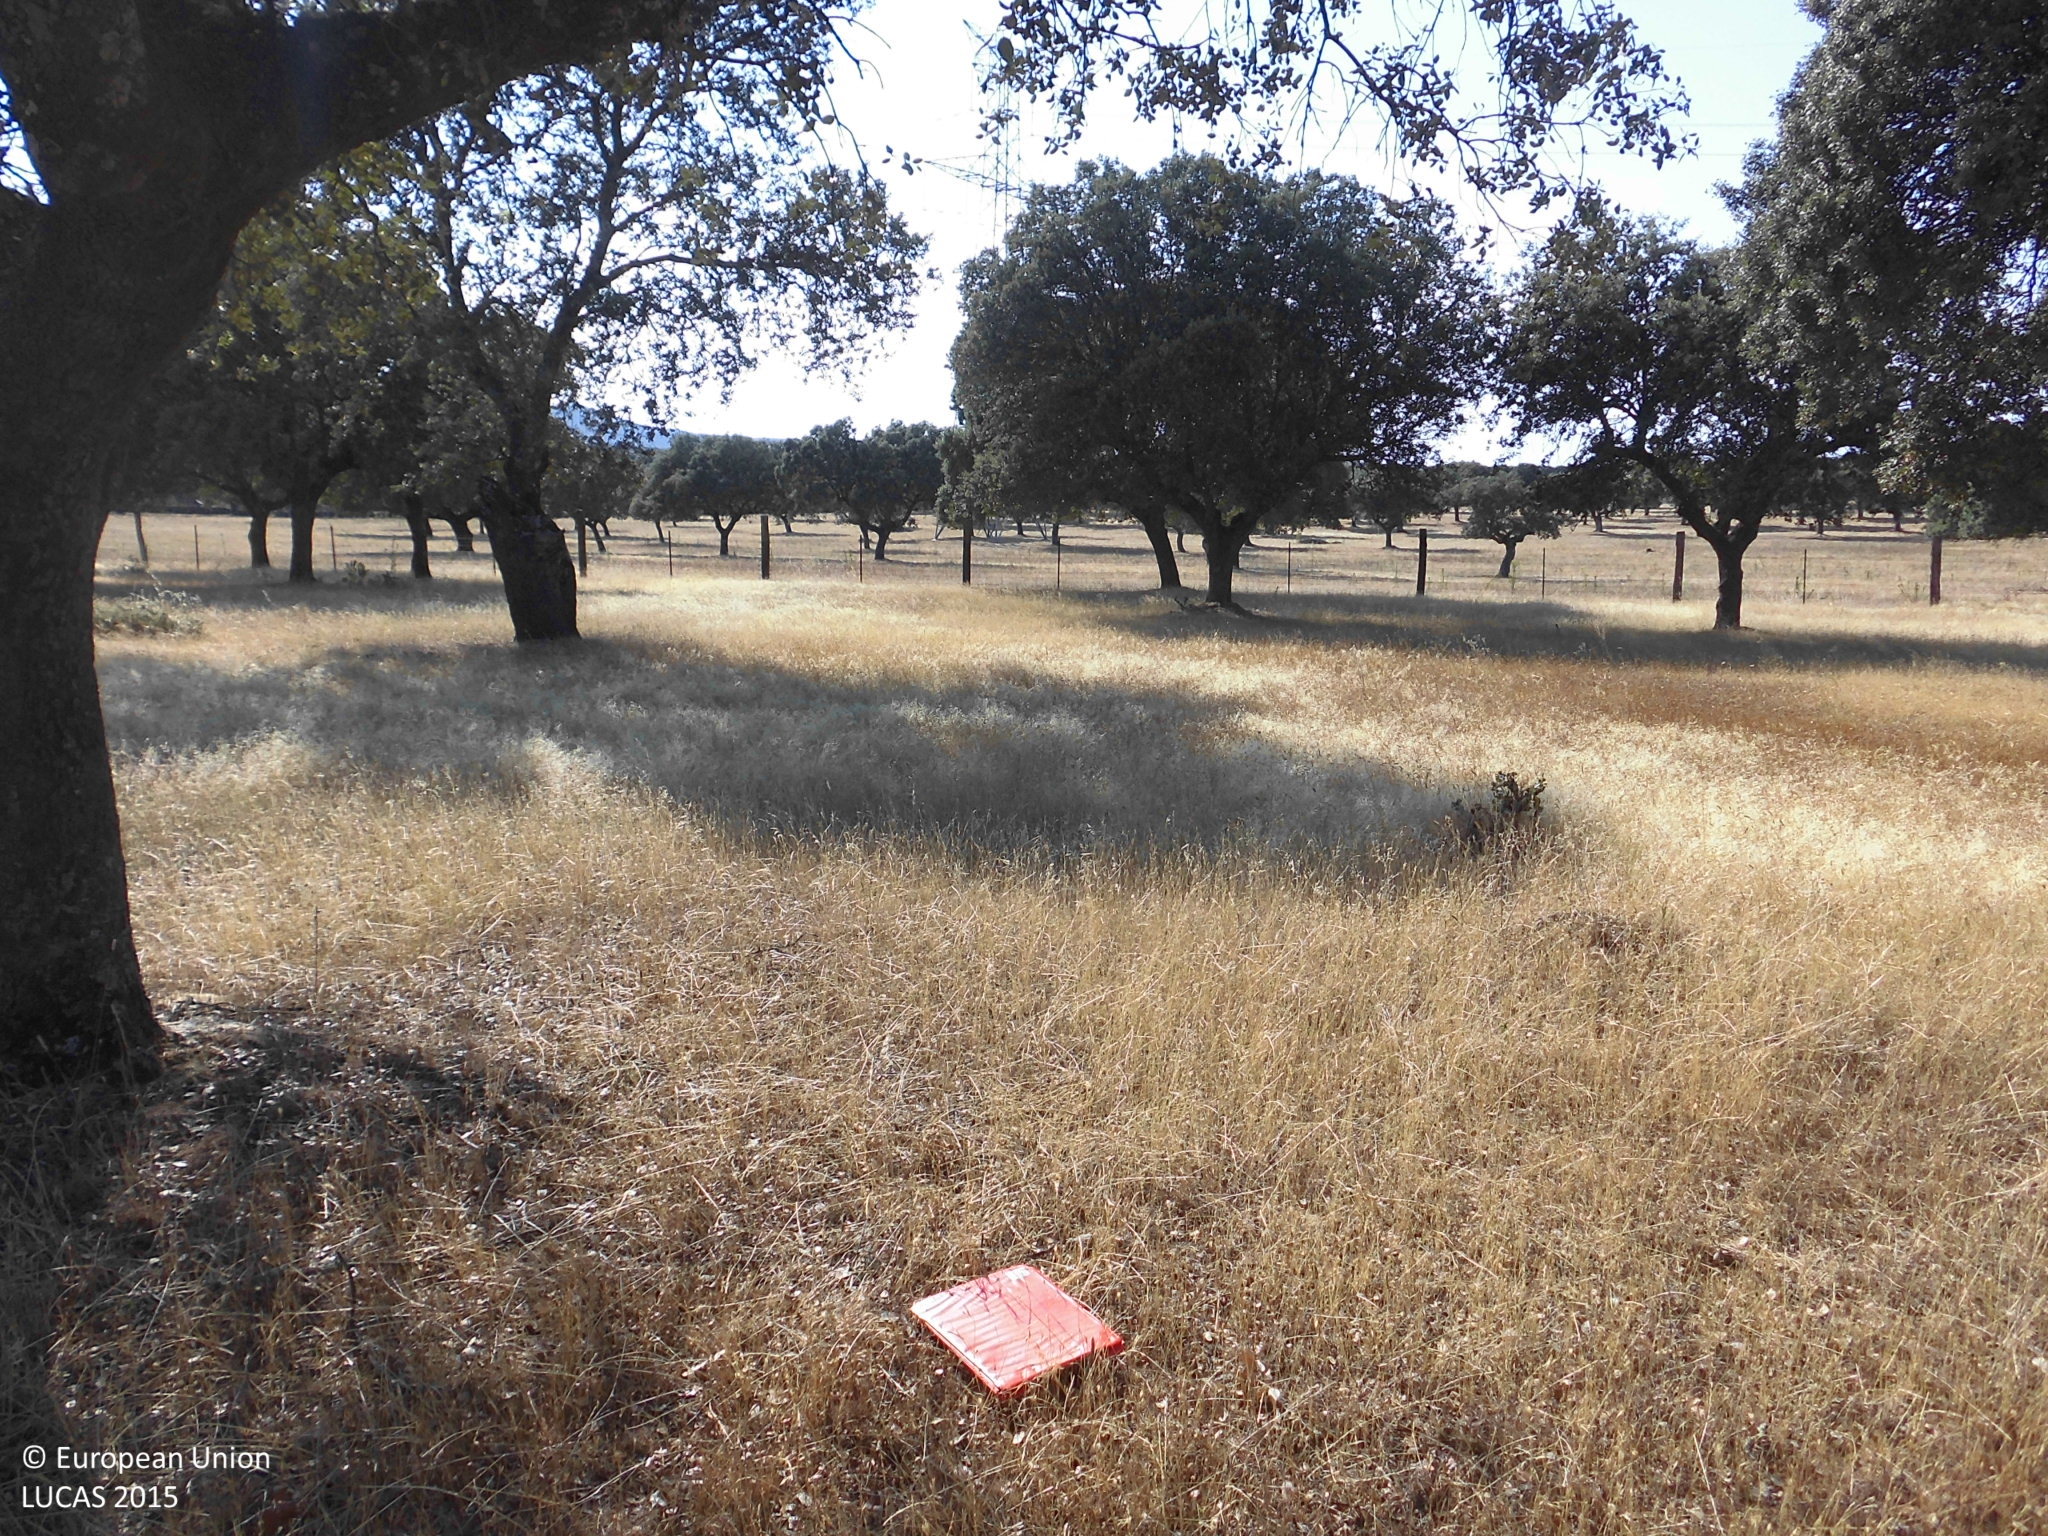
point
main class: Woodland
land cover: Broadleaved woodland
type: broadleaved evergreen forest
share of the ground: 25 - 50 %
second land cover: Grassland without tree/shrub cover
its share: > 75 %
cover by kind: broadleaved forest trees 50 %, herbaceous plants 50 %
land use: Forestry
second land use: Agriculture (excluding fallow land and kitchen gardens)
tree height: > 5 m
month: June
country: ES
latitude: 39.9376
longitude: -6.1148
